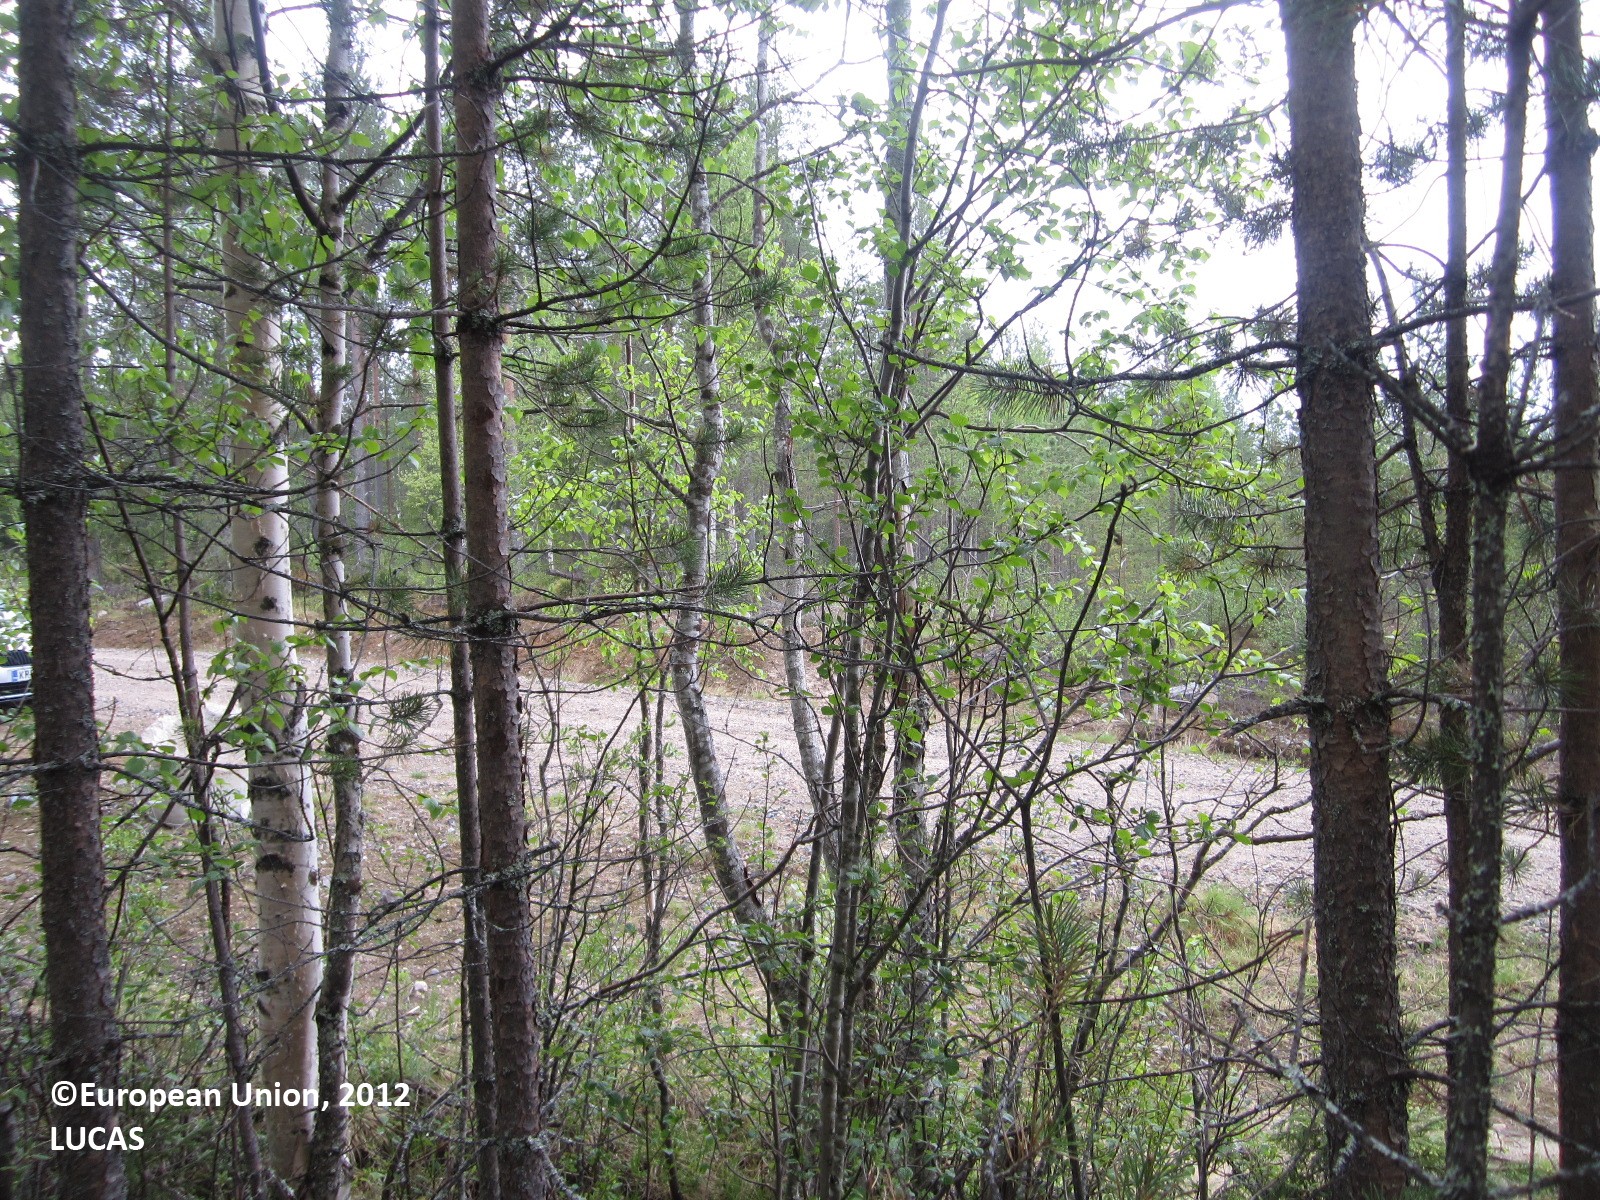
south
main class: Woodland
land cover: Pine dominated mixed woodland
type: boreal forest
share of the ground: > 75 %
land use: Forestry
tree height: > 5 m
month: June
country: FI
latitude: 64.7478
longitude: 28.6880
